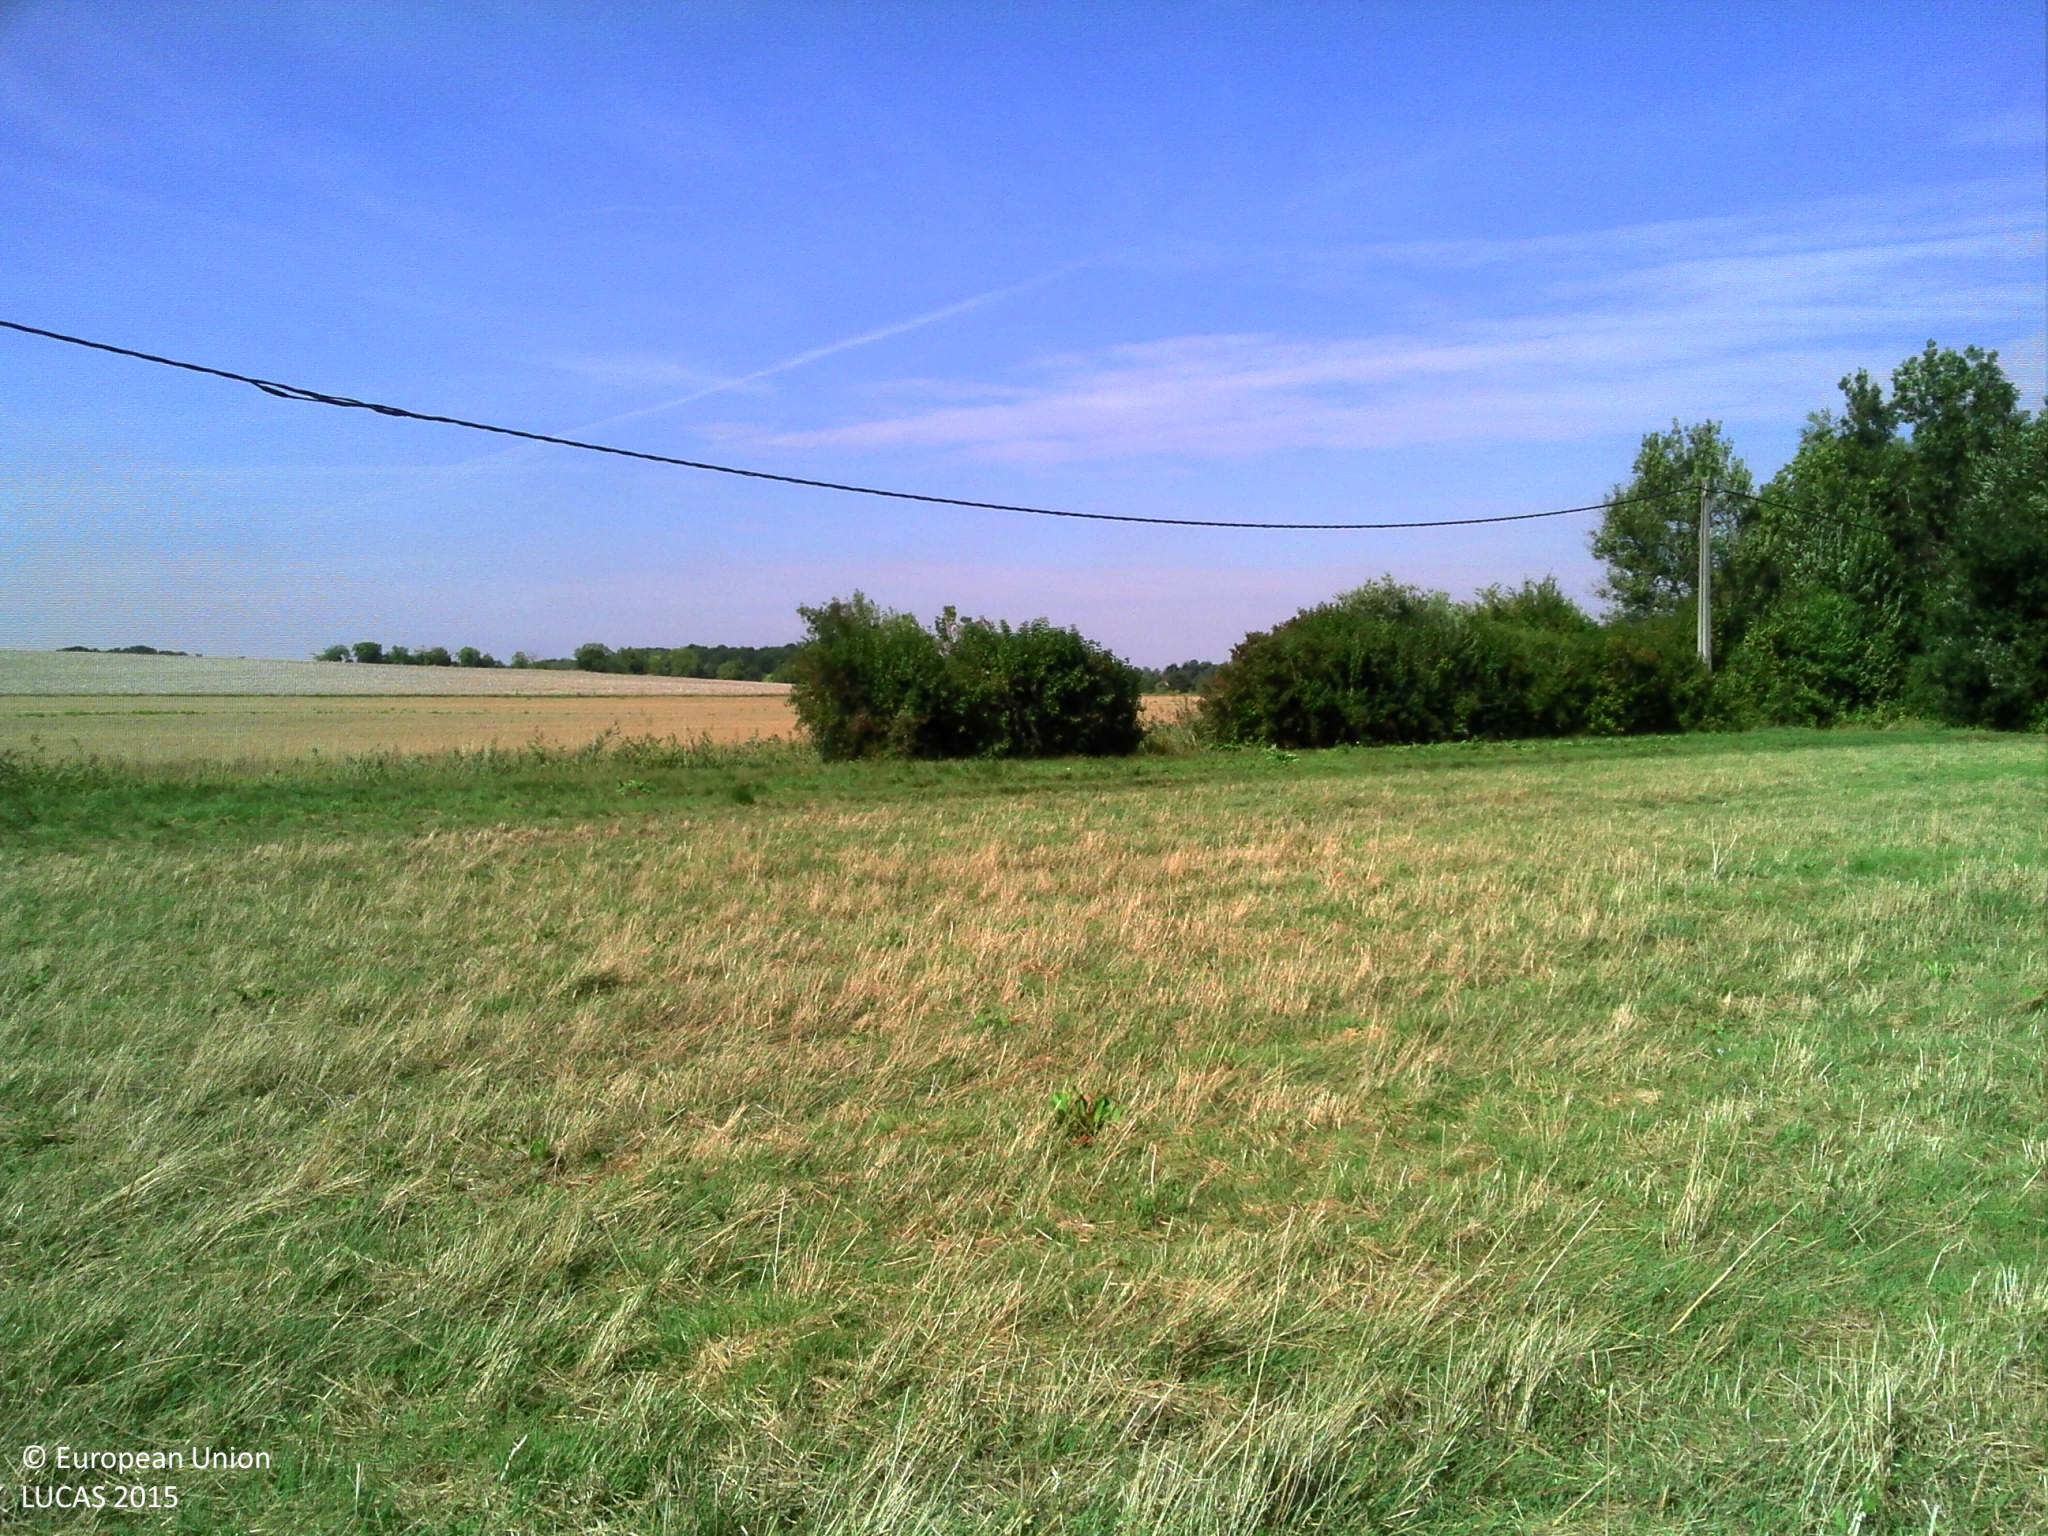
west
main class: Grassland
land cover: Grassland without tree/shrub cover
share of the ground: > 75 %
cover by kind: herbaceous plants 100 %
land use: Agriculture (excluding fallow land and kitchen gardens)
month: August
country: FR
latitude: 48.3081
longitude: 2.7236
